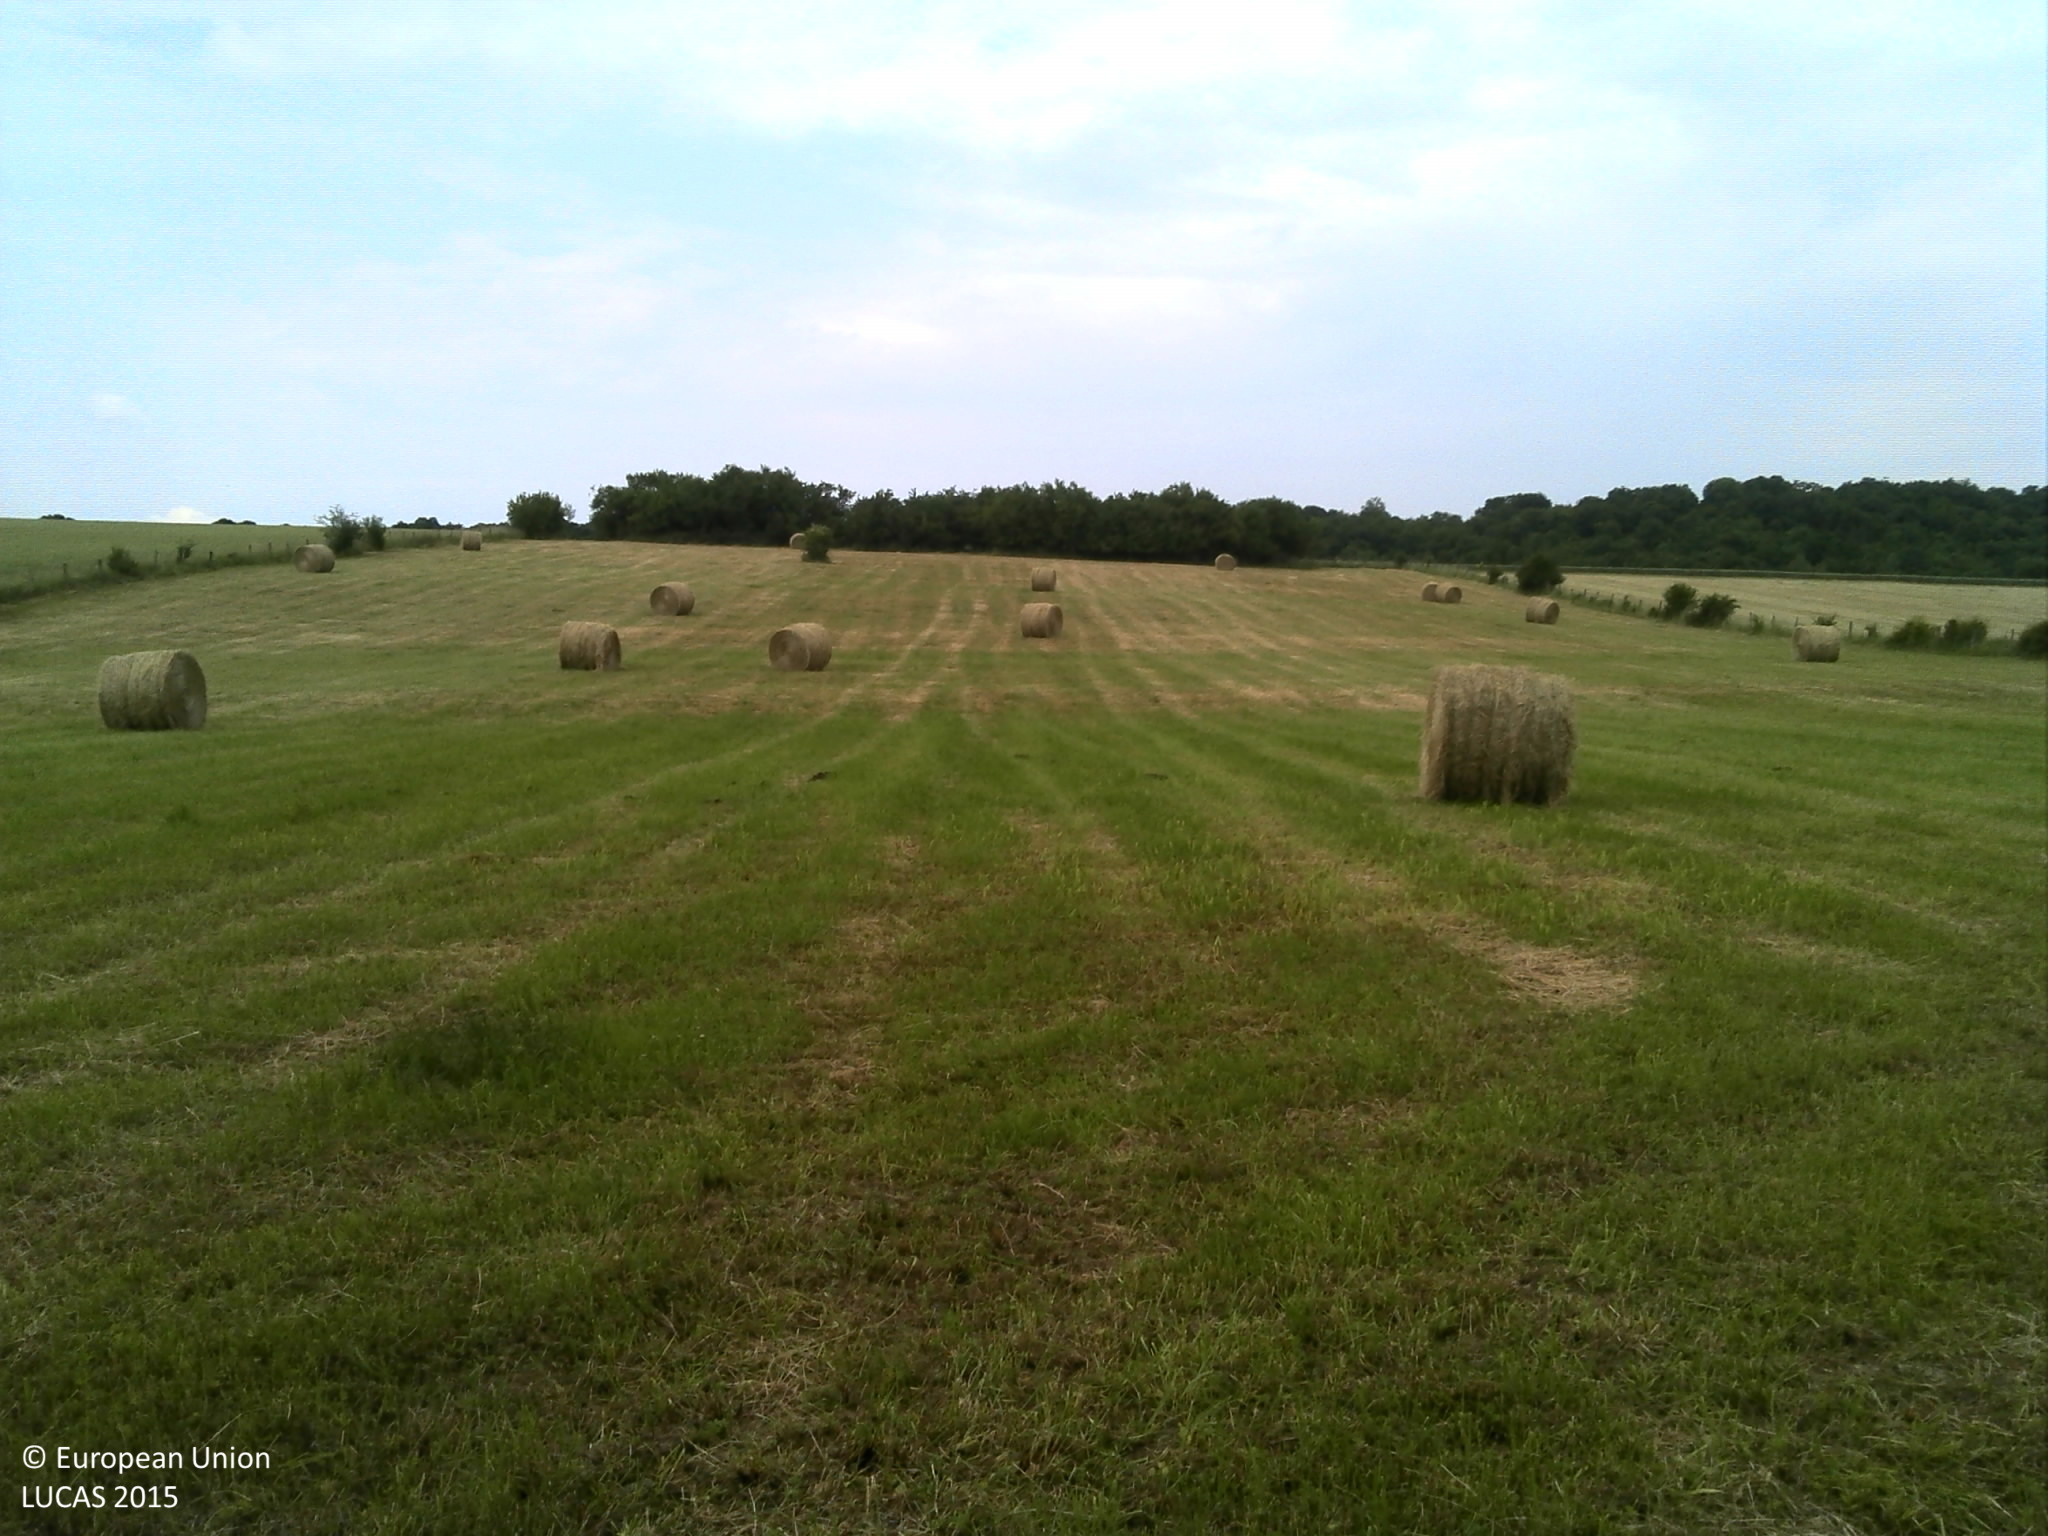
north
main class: Grassland
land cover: Grassland without tree/shrub cover
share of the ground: > 75 %
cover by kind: herbaceous plants 100 %
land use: Agriculture (excluding fallow land and kitchen gardens)
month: June
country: FR
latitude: 49.2404
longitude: 6.2500
